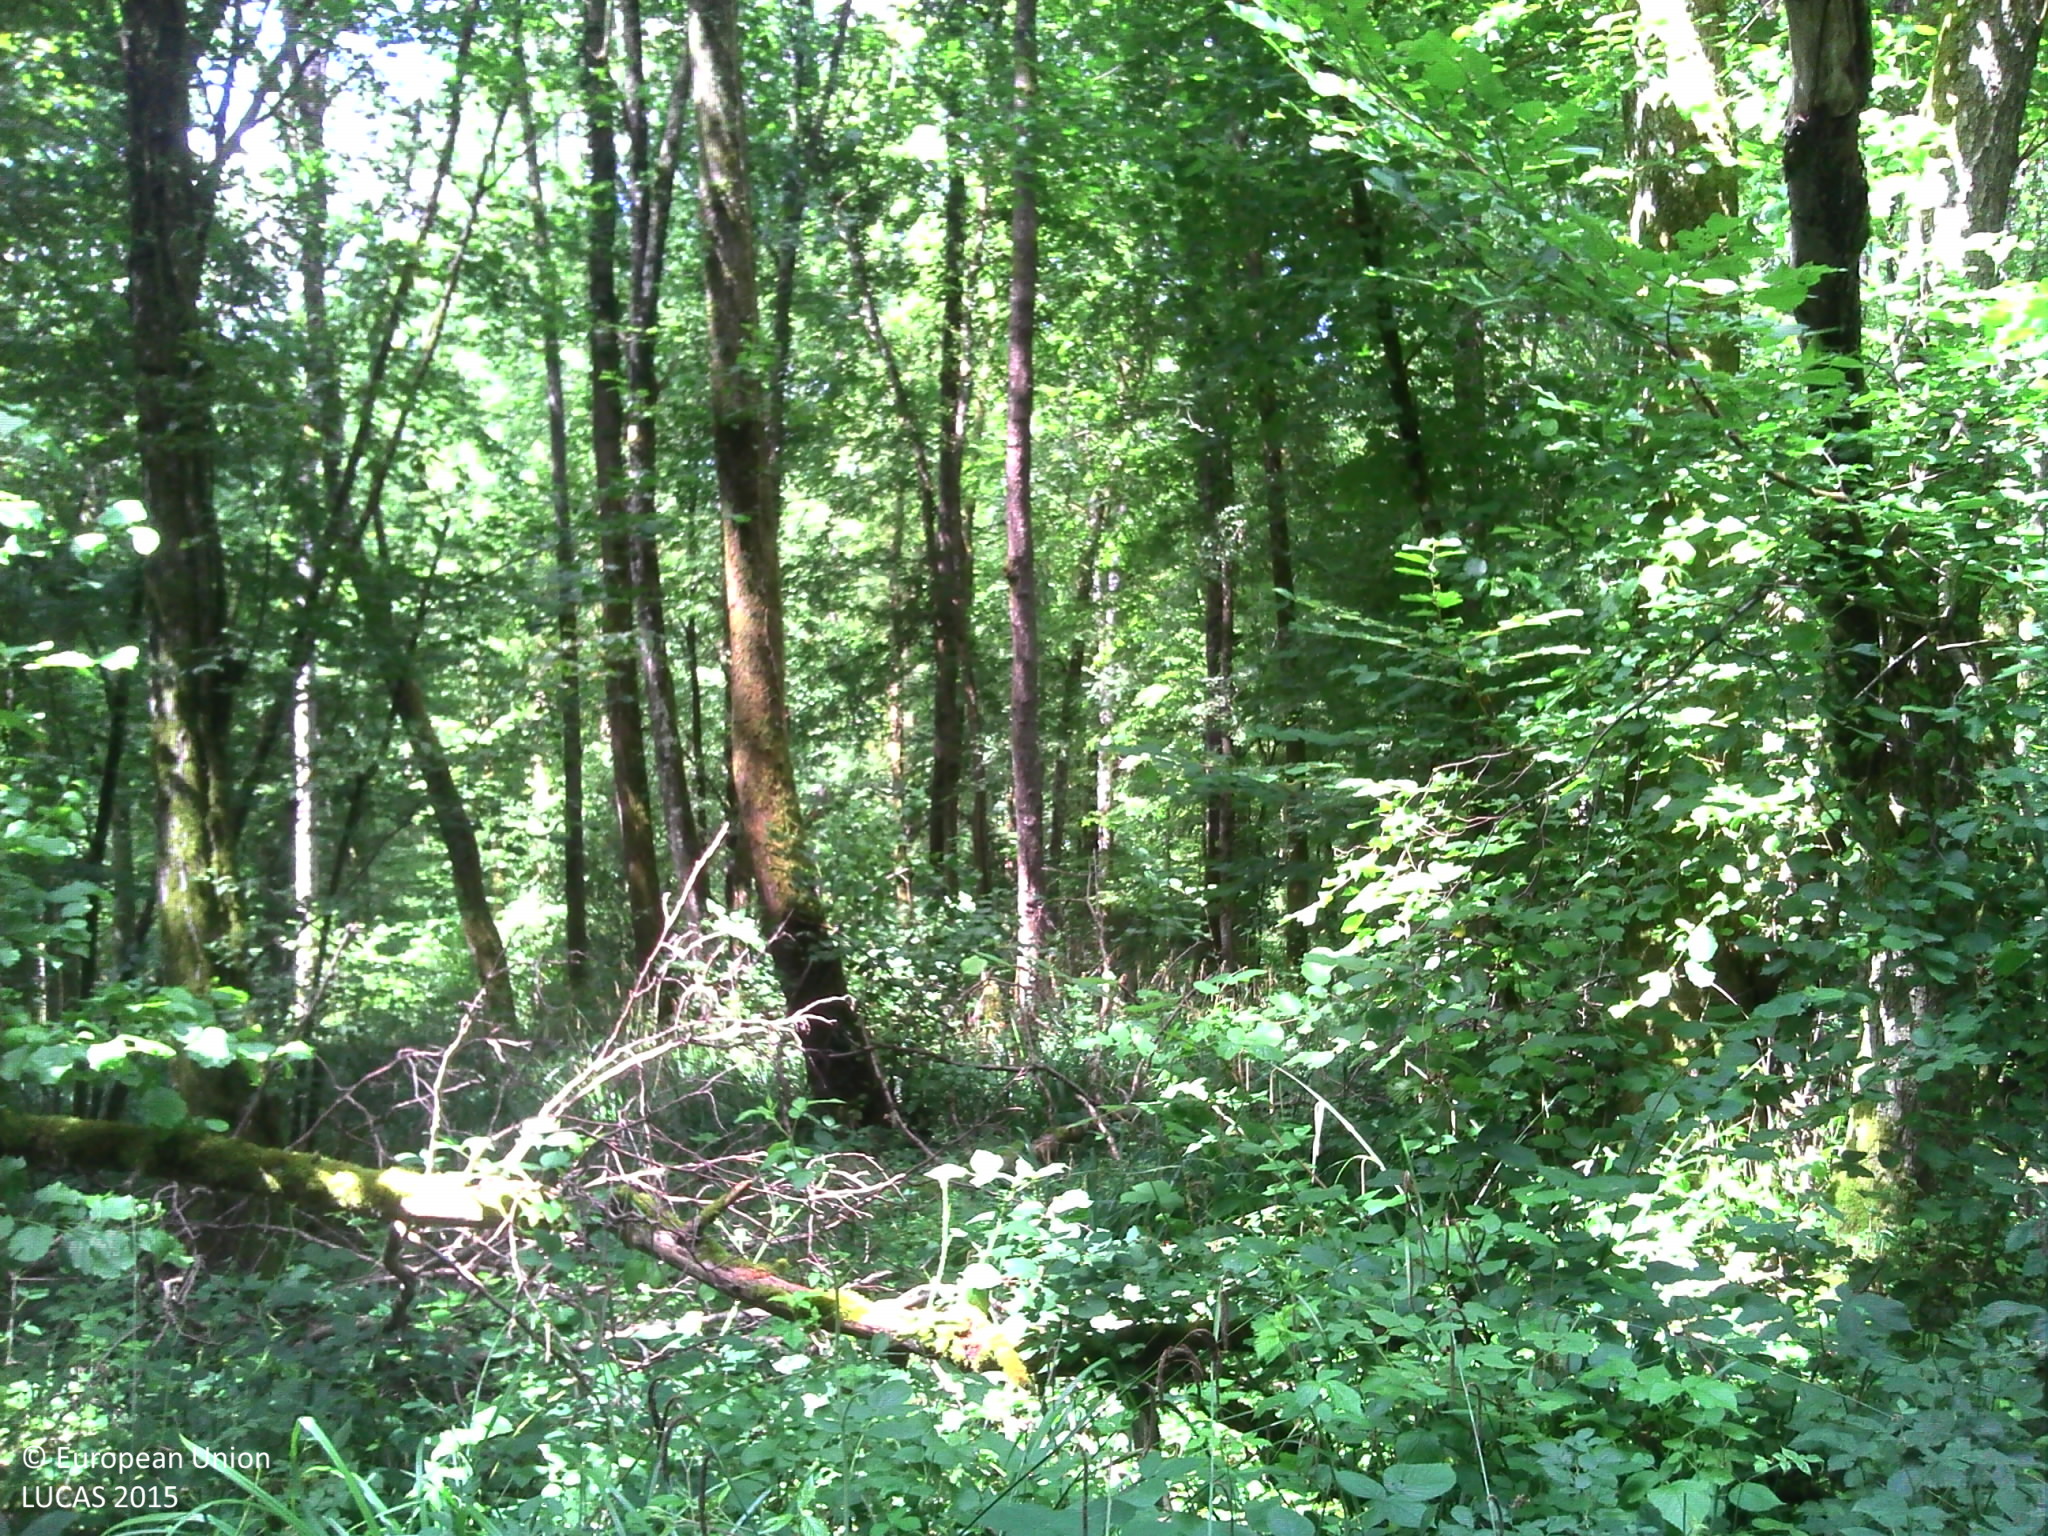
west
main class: Woodland
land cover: Broadleaved woodland
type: mesophytic deciduous forest
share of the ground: > 75 %
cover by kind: broadleaved forest trees 95 %, herbaceous plants 5 %
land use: Forestry
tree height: > 5 m
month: July
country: FR
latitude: 49.1781
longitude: 5.1007
